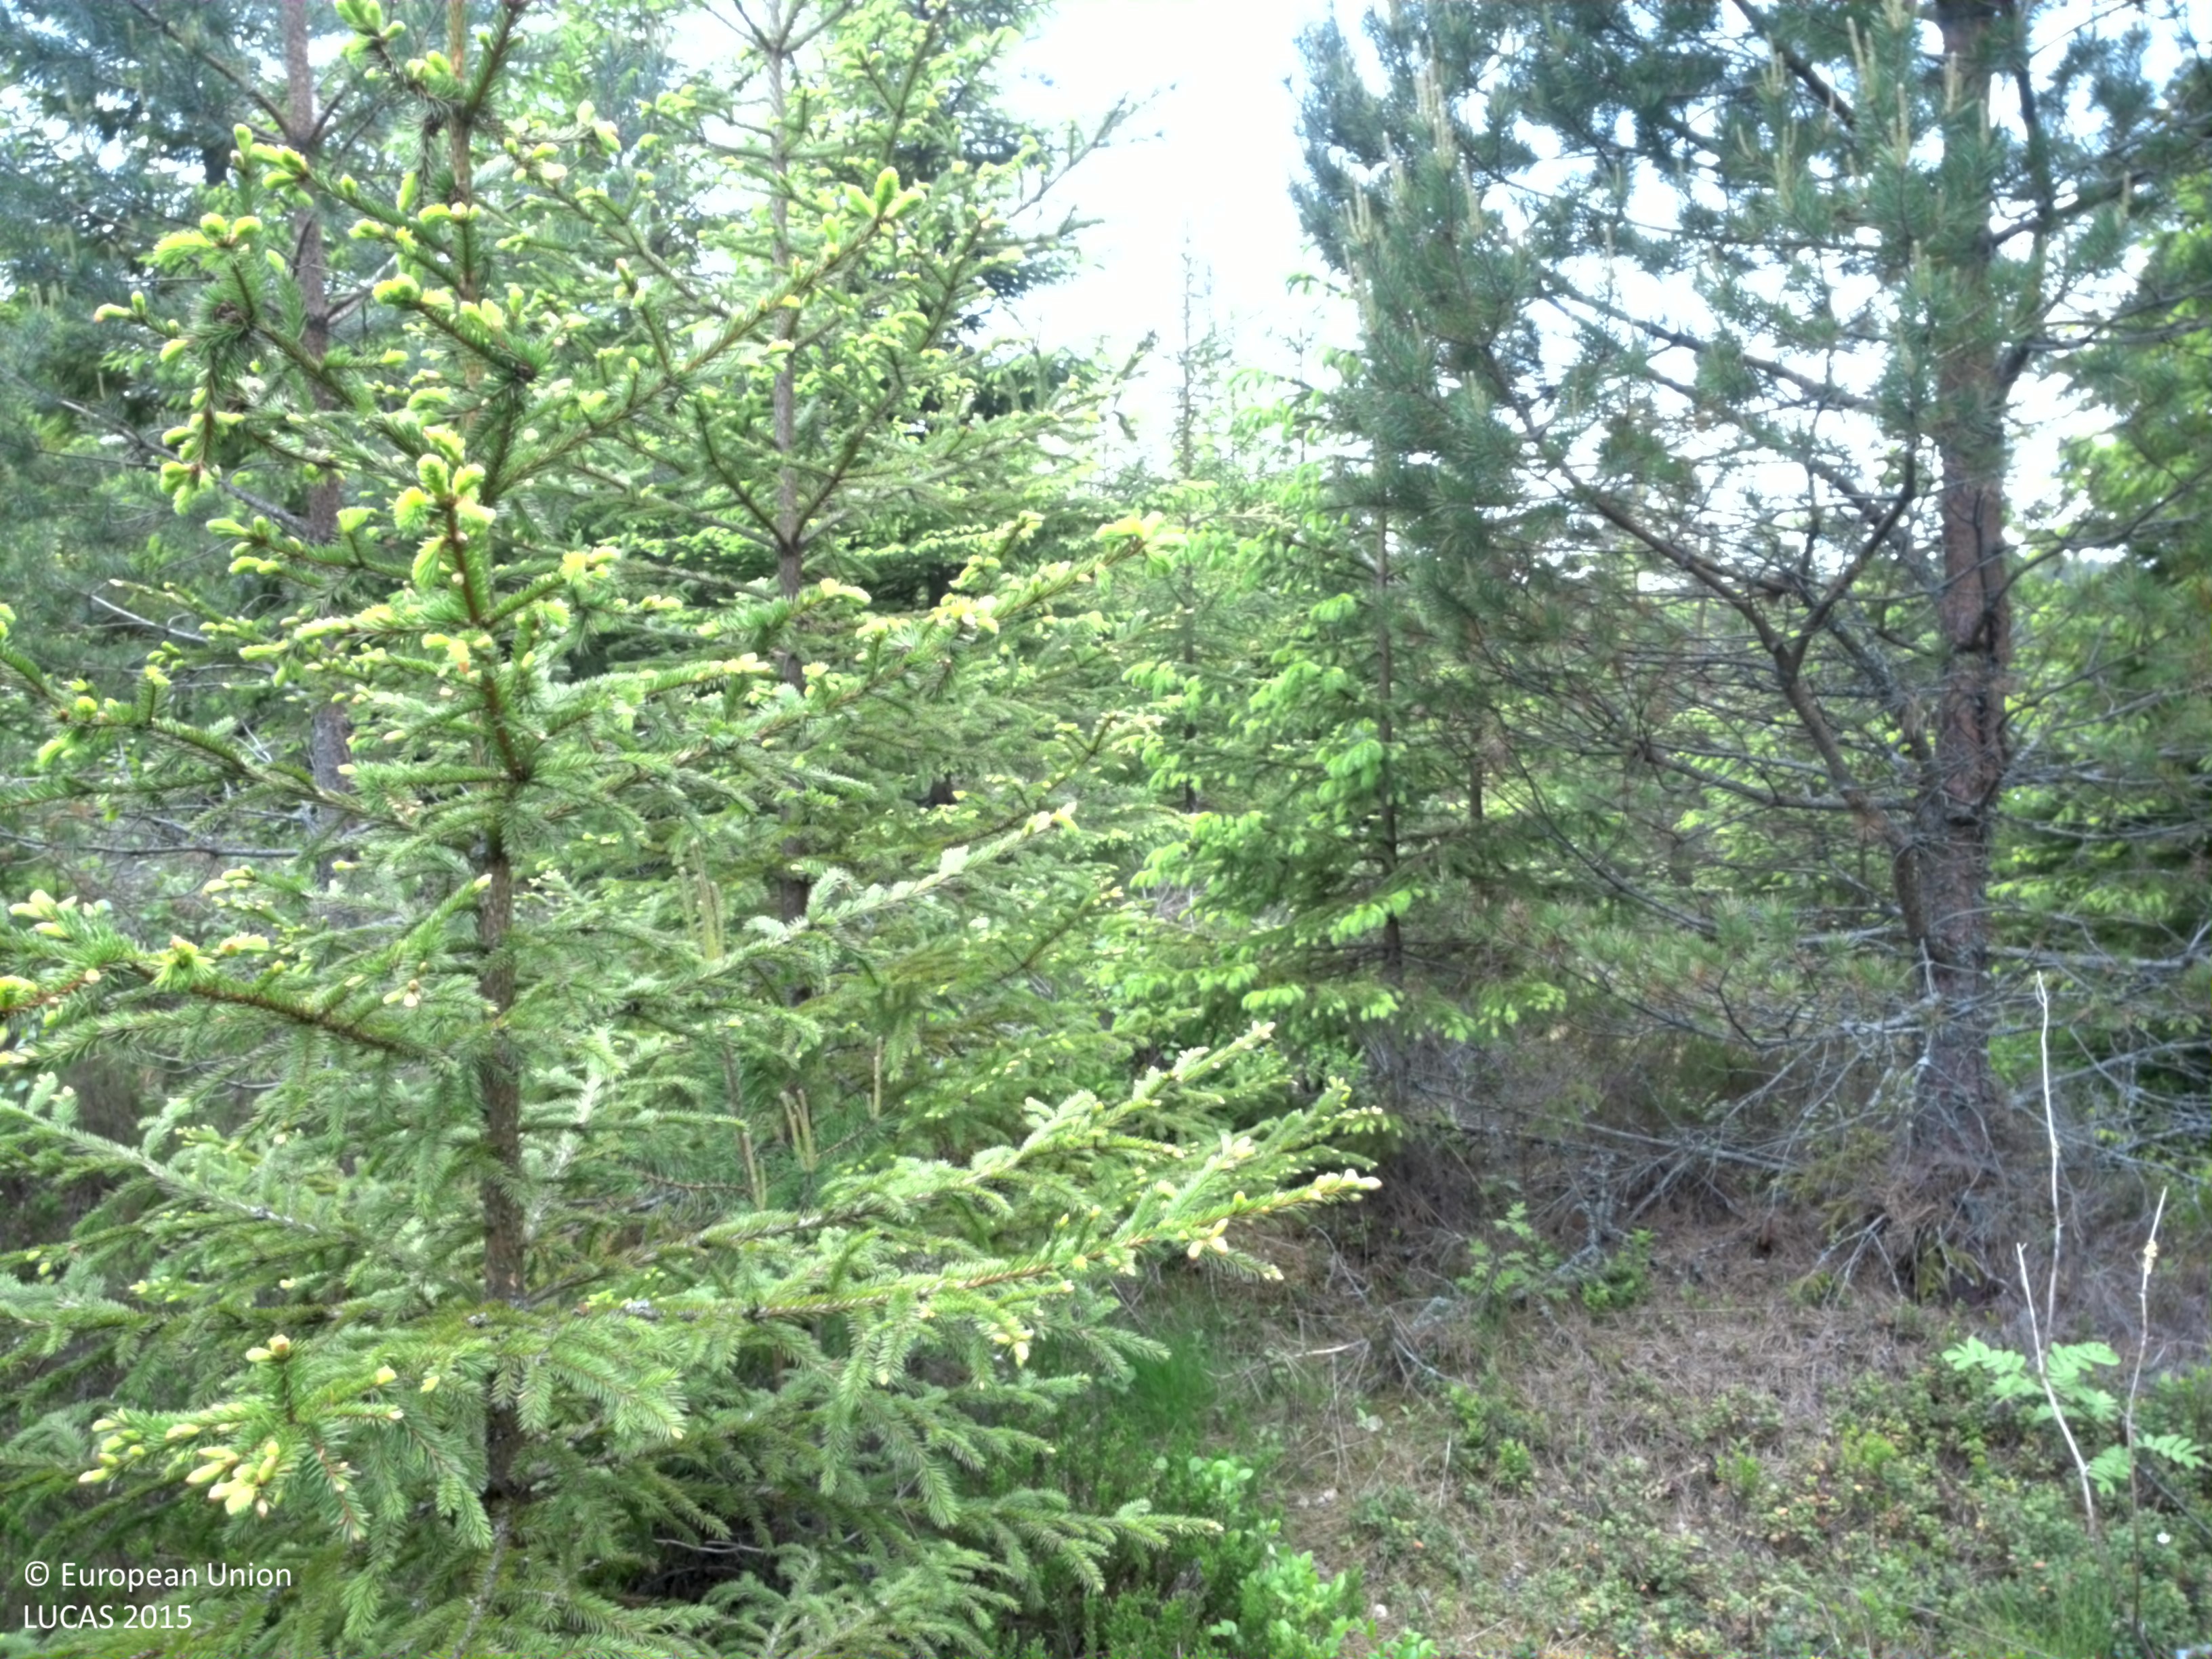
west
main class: Woodland
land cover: Spruce dominated mixed woodland
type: boreal forest
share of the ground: 50 - 75 %
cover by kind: coniferous forest trees 40 %, broadleaved forest trees 30 %, shrubs 15 %, herbaceous plants 10 %, lichens and mosses 5 %
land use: Forestry
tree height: < 5 m
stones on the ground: < 10 %
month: June
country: SE
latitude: 59.5892
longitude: 14.4008
